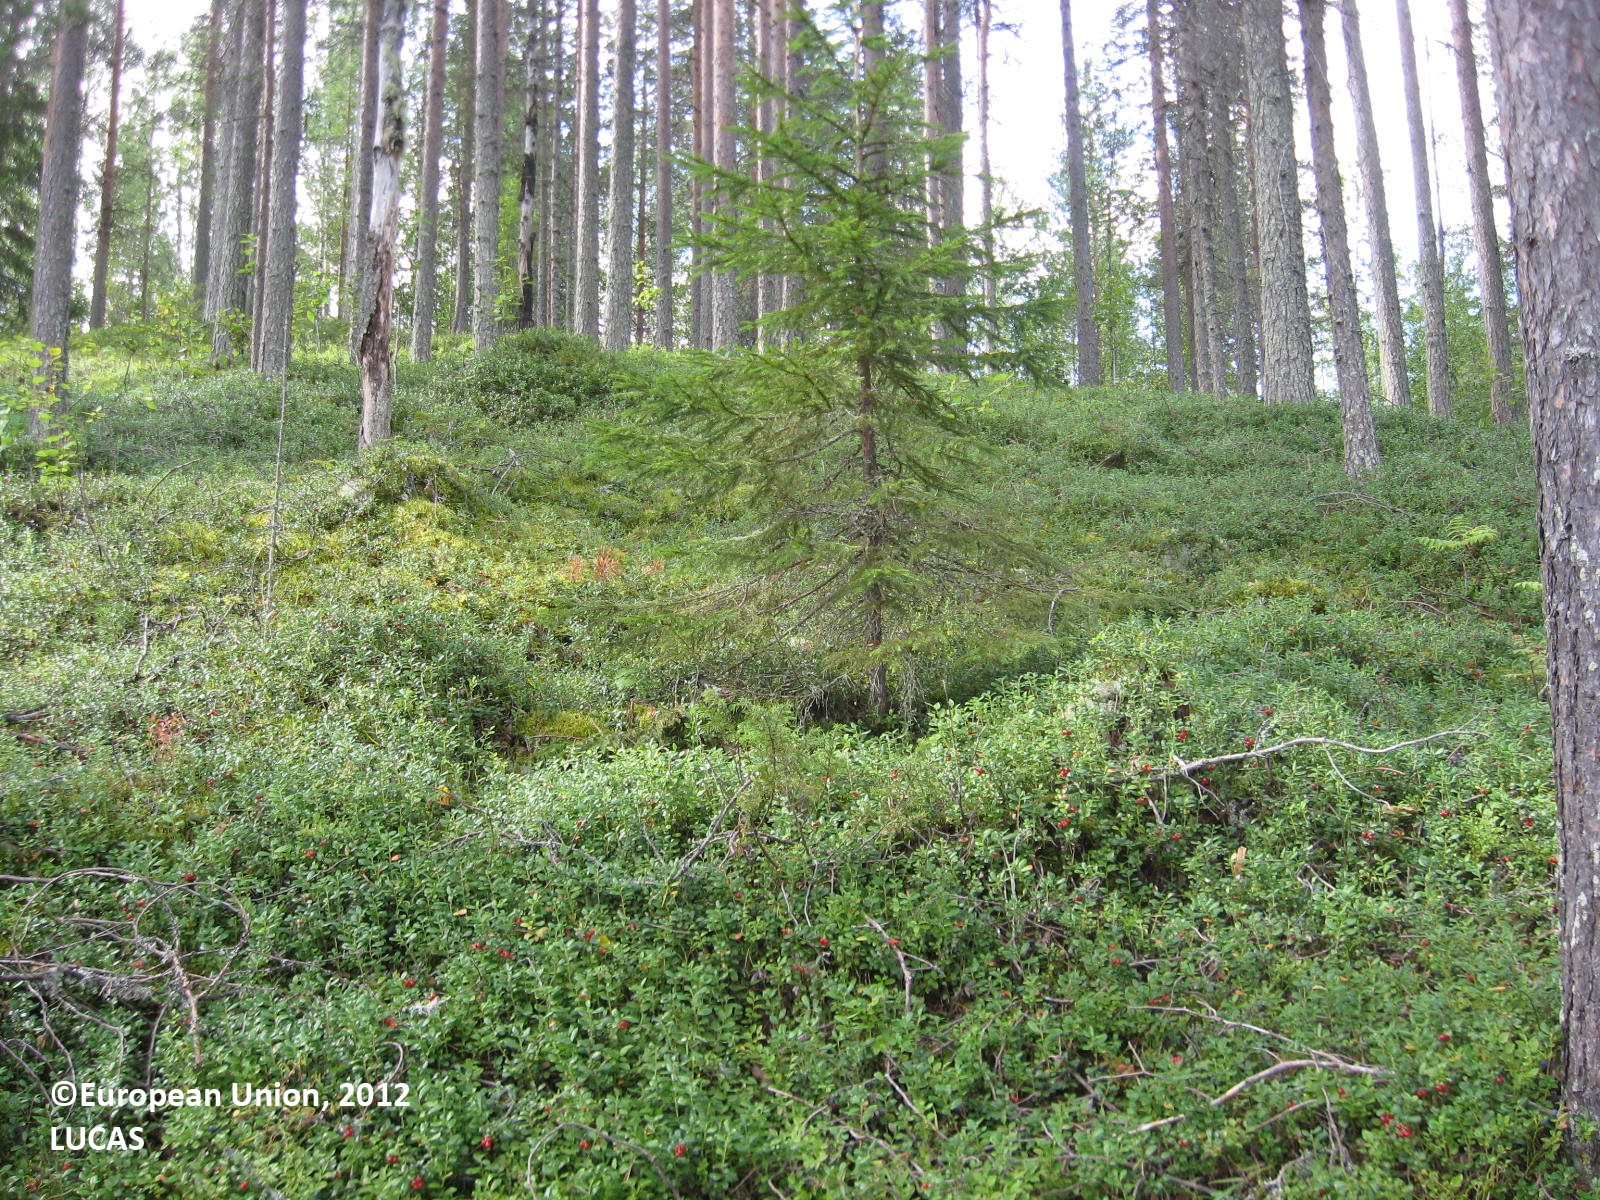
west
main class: Woodland
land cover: Pine dominated coniferous woodland
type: boreal forest
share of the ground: < 10 %
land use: Forestry
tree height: > 5 m
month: August
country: FI
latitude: 63.5073
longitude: 30.3352
